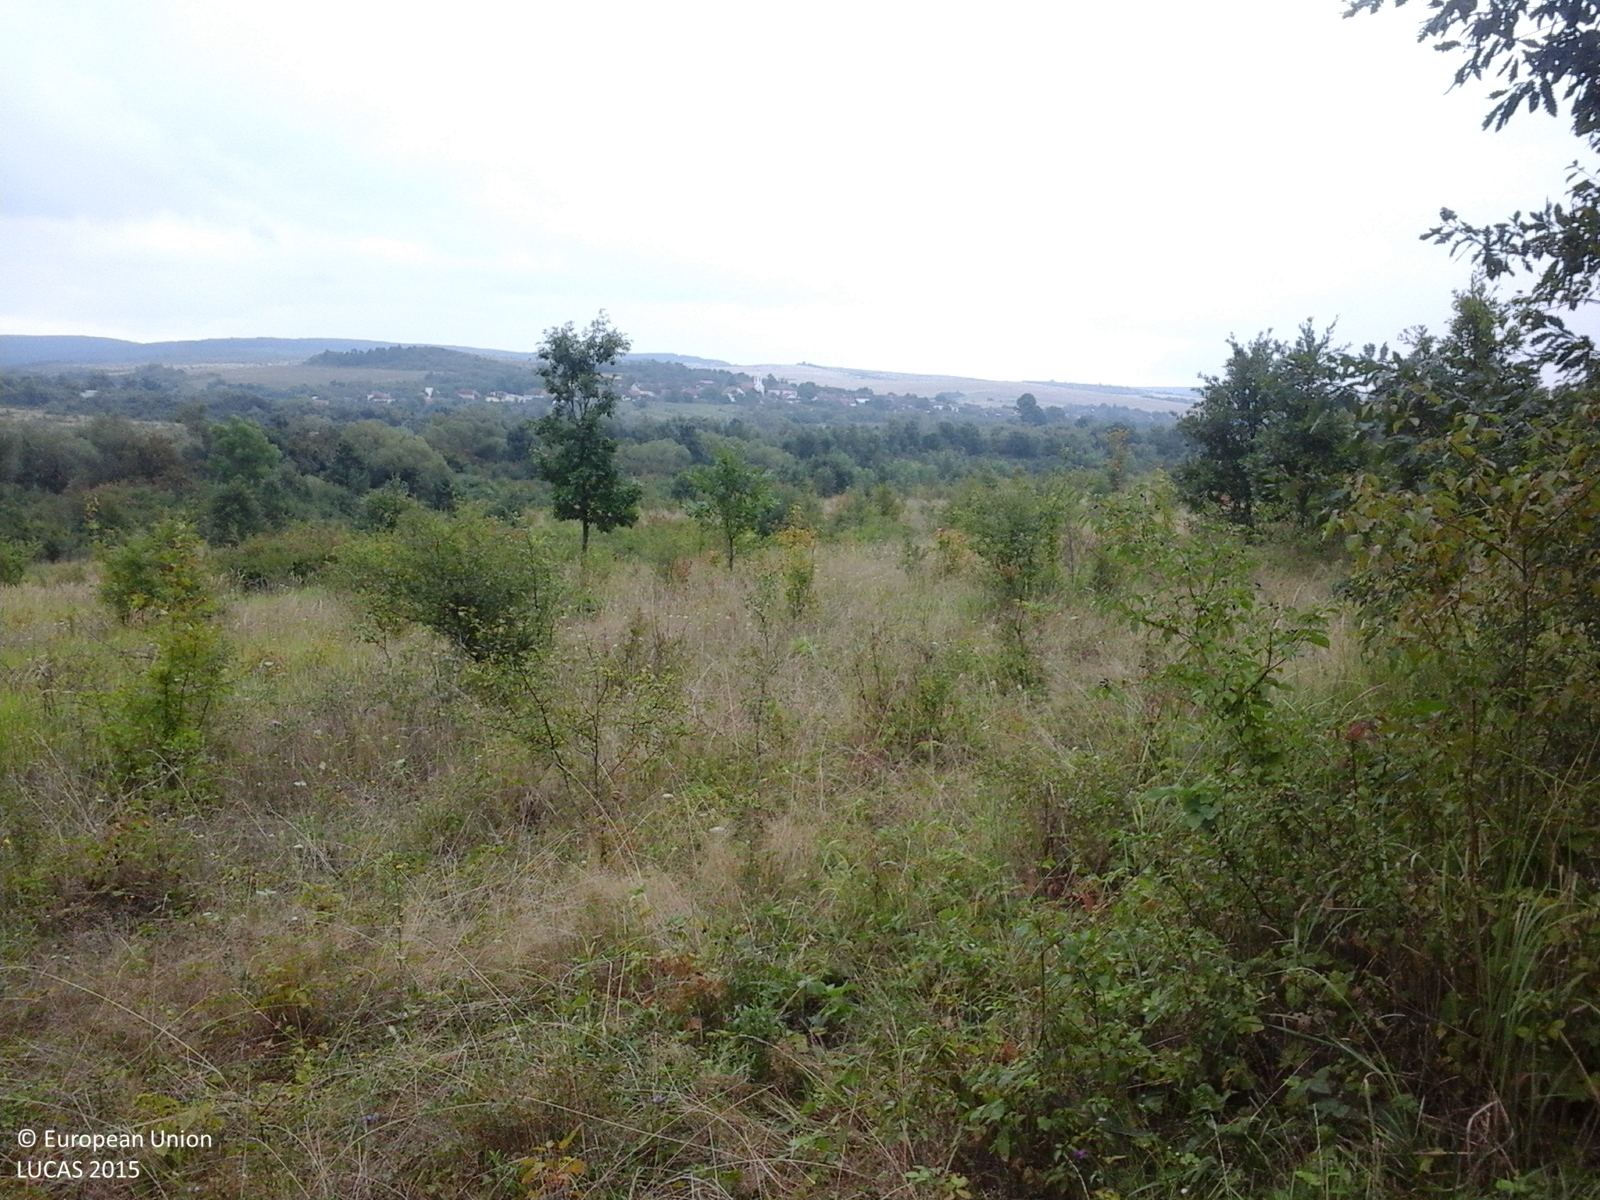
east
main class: Grassland
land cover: Grassland with sparse tree/shrub cover
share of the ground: > 75 %
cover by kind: herbaceous plants 85 %, shrubs 10 %, broadleaved forest trees 5 %
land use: Fallow land
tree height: > 5 m
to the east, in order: Grassland with sparse tree/shrub cover
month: August
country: RO
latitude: 45.9766
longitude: 21.5617
